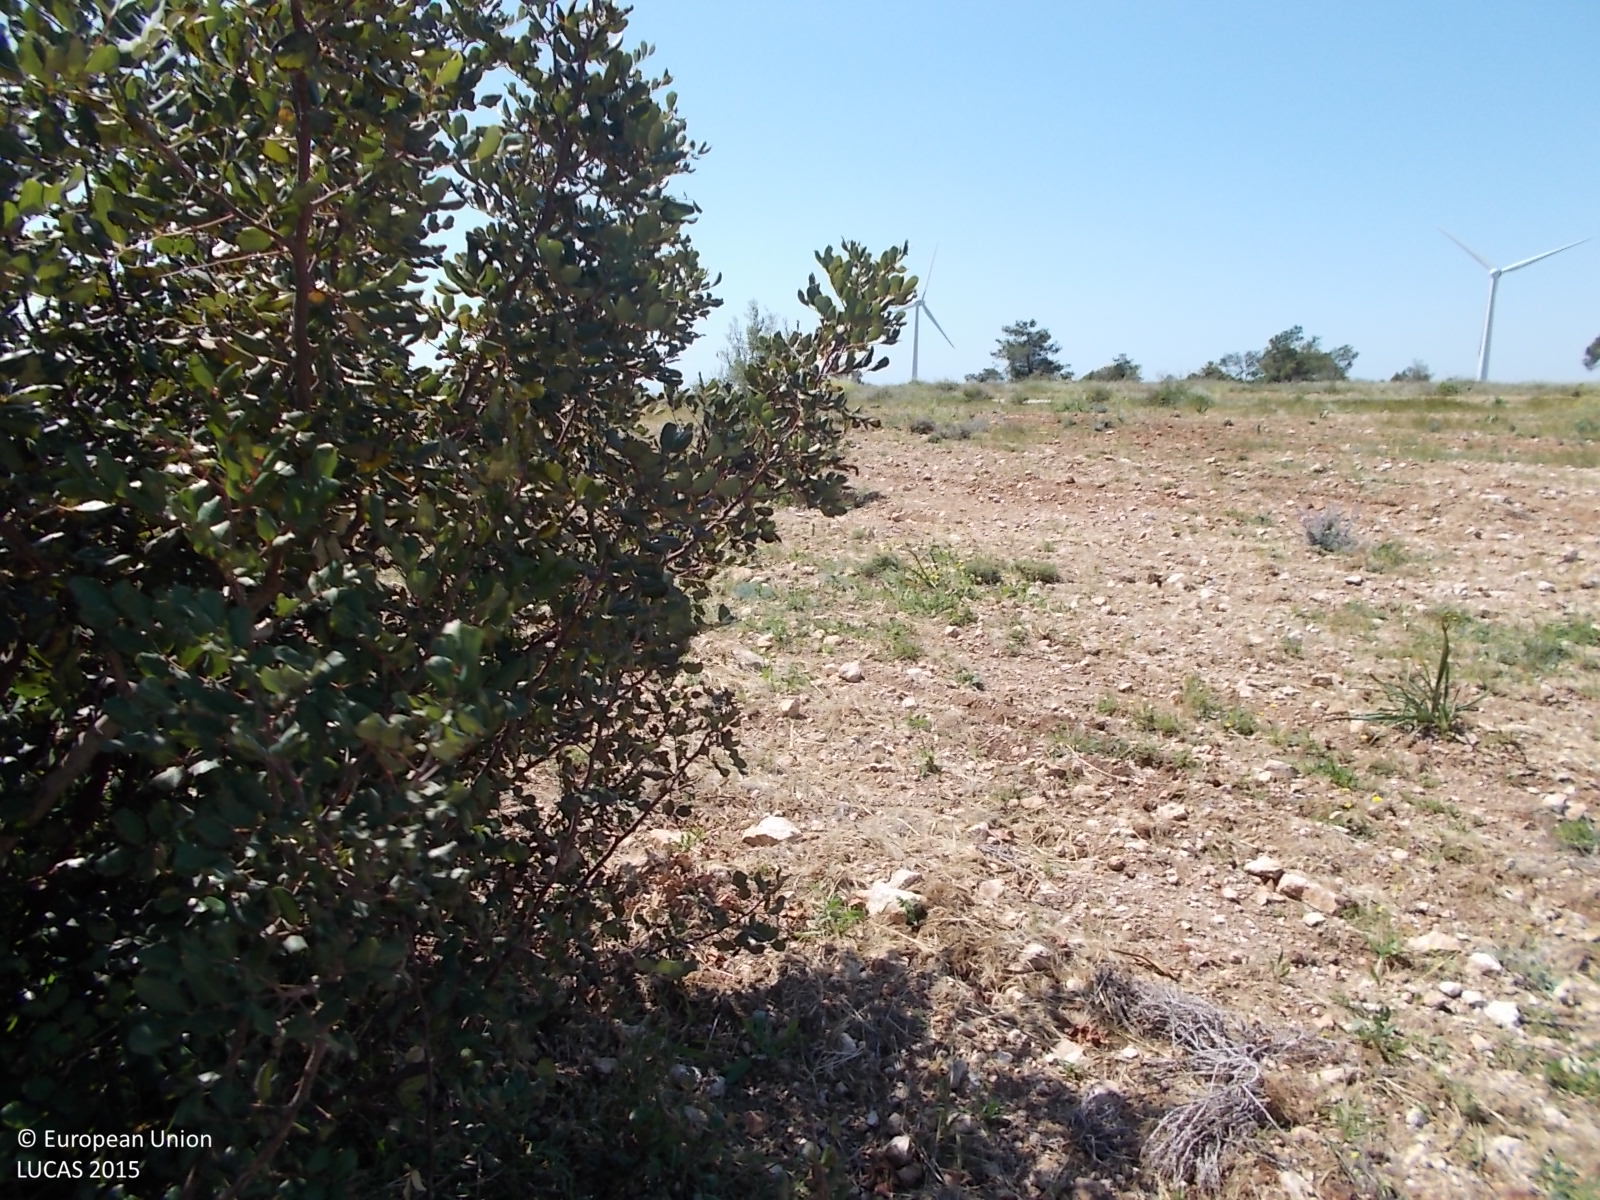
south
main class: Shrubland
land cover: Shrubland without tree cover
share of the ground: 10 - 25 %
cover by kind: unconsolidated bare surface 55 %, herbaceous plants 25 %, shrubs 20 %
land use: Energy production
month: April
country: CY
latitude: 34.8651
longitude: 33.5228
